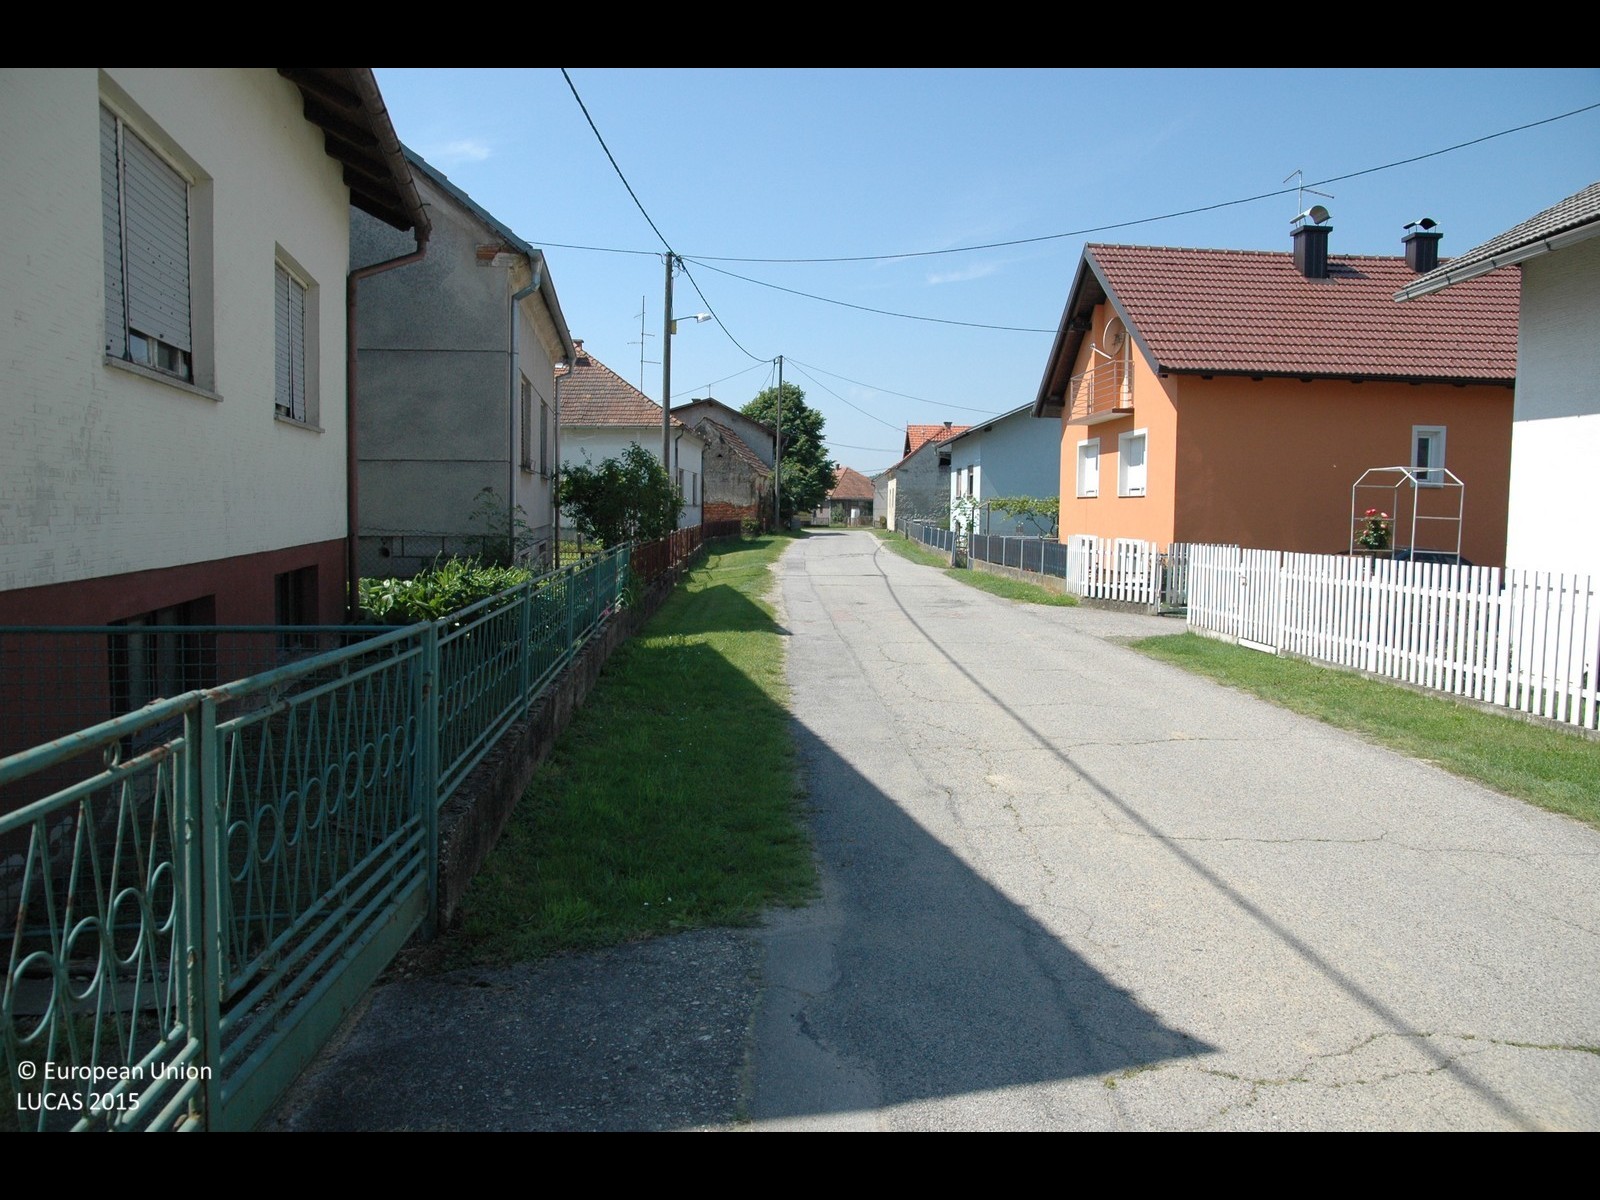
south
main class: Grassland
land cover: Grassland without tree/shrub cover
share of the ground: > 75 %
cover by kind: herbaceous plants 100 %
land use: Residential
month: May
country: HR
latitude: 46.5207
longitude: 16.4012
